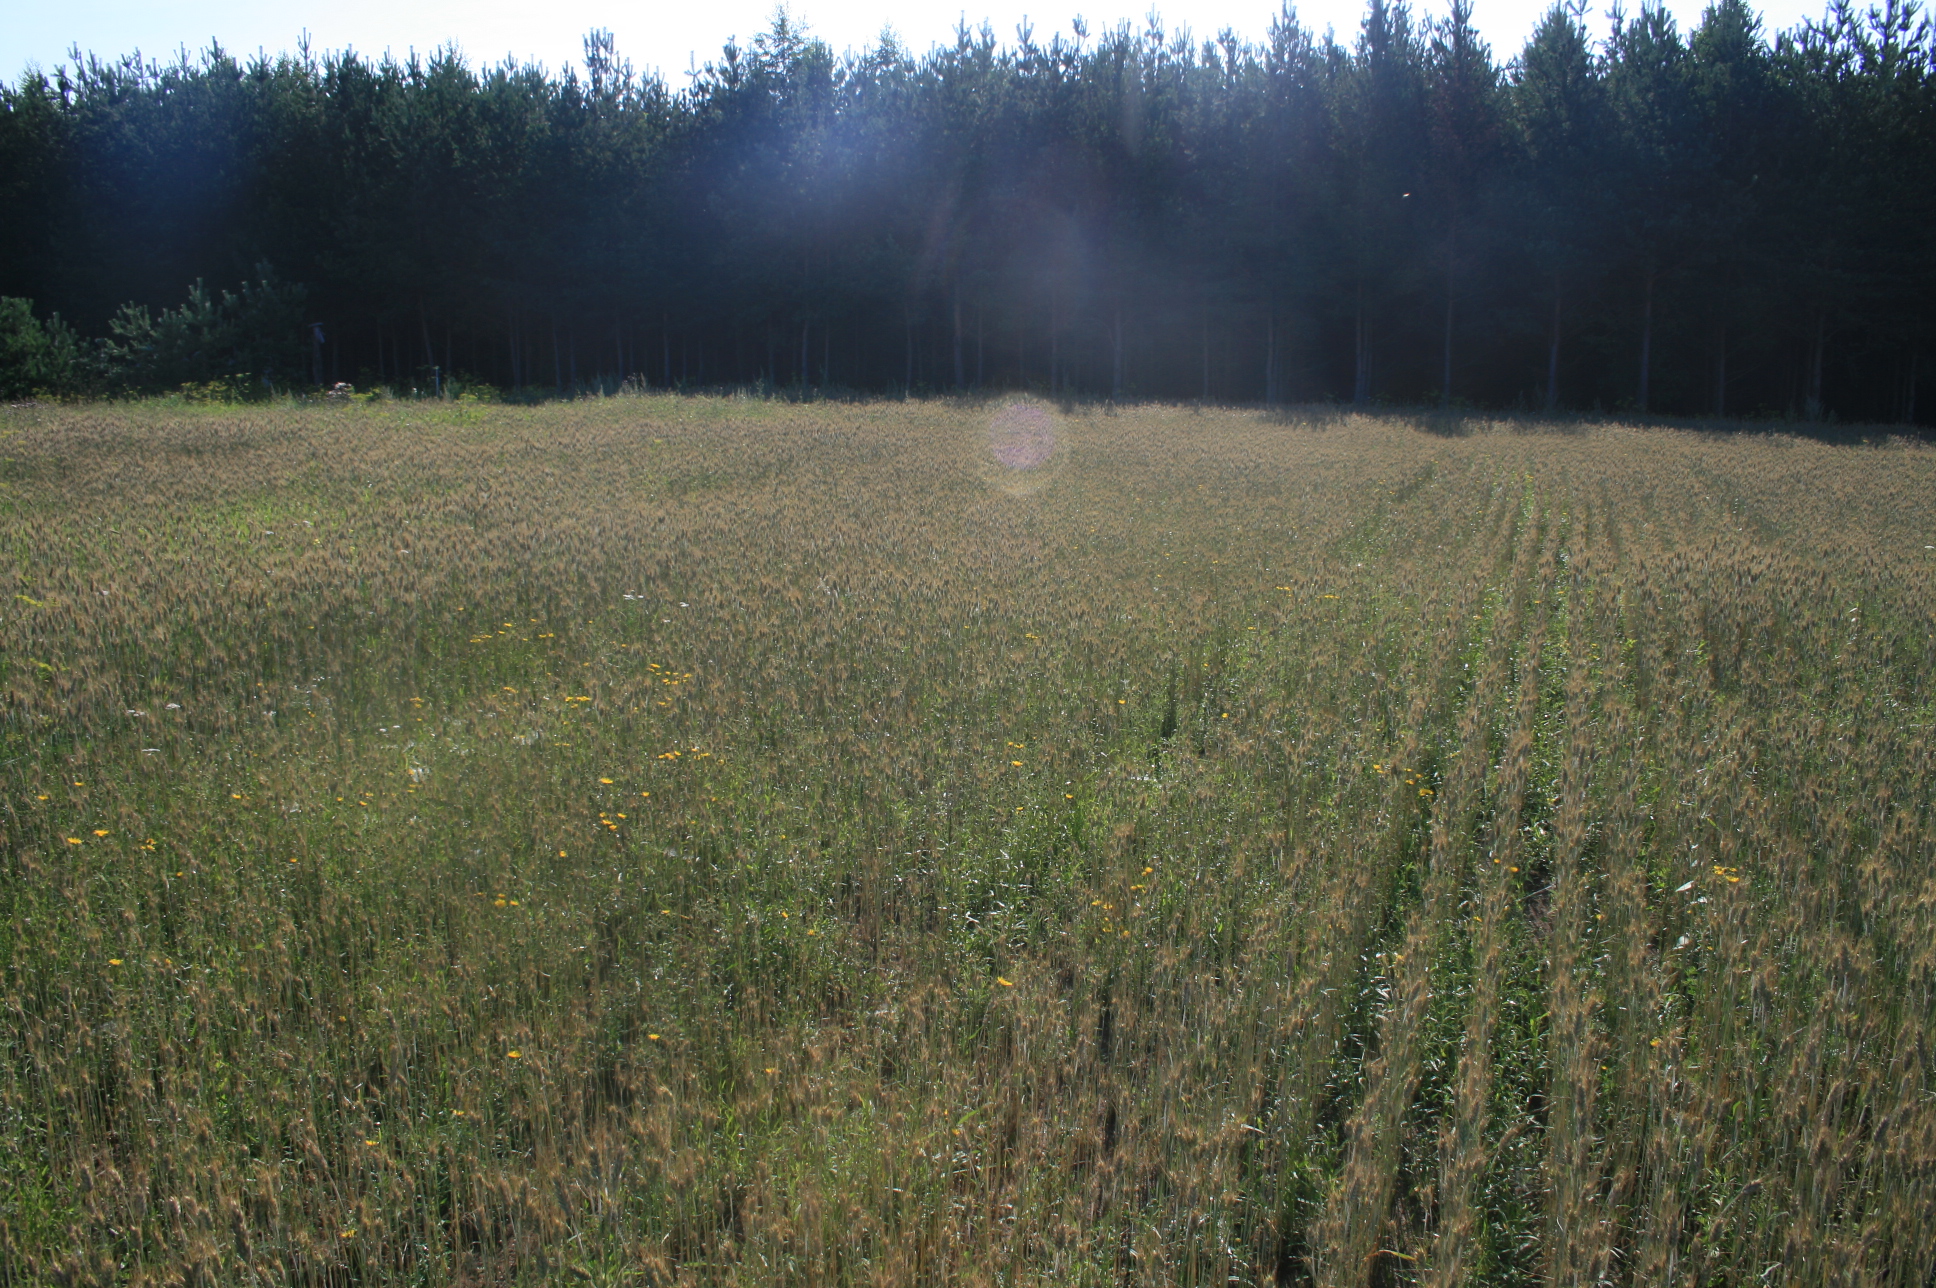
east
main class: Cropland
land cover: Common wheat
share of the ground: > 75 %
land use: Agriculture (excluding fallow land and kitchen gardens)
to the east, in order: Common wheat; Grass margins; Tracks; Pine dominated coniferous woodland; Other coniferous woodland; Pine dominated mixed woodland
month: August
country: LT
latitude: 55.6263
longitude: 21.3672
